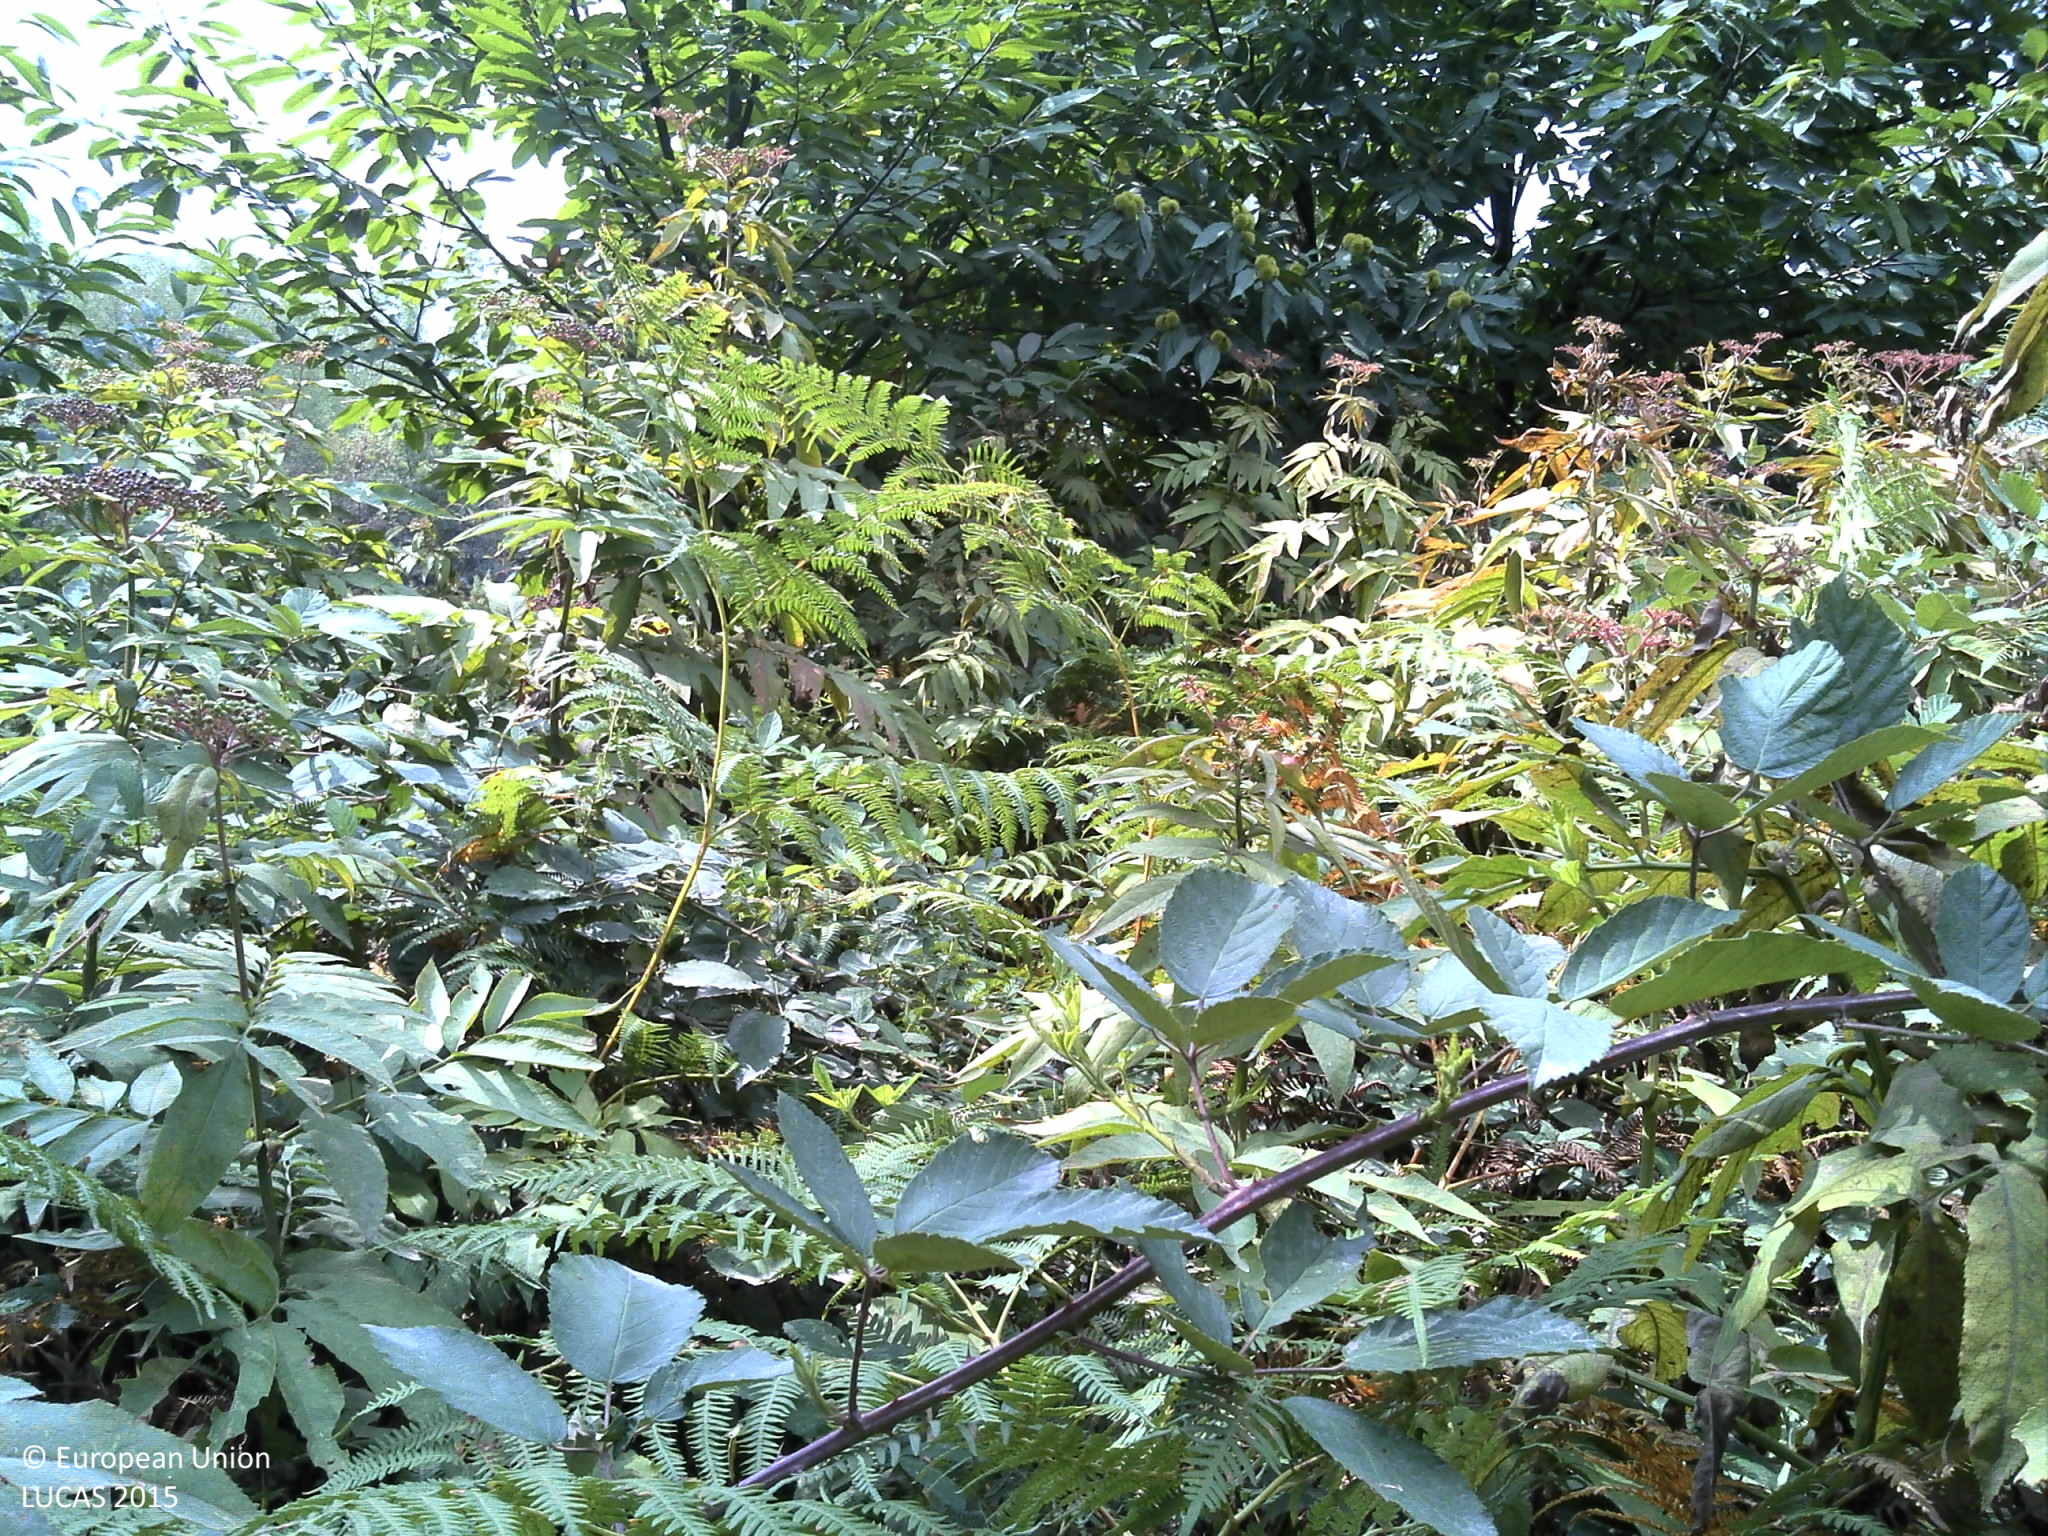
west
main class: Shrubland
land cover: Shrubland with sparse tree cover
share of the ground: > 75 %
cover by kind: shrubs 95 %, broadleaved forest trees 5 %
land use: Forestry
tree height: < 5 m
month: August
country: HR
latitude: 45.2227
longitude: 16.0456
